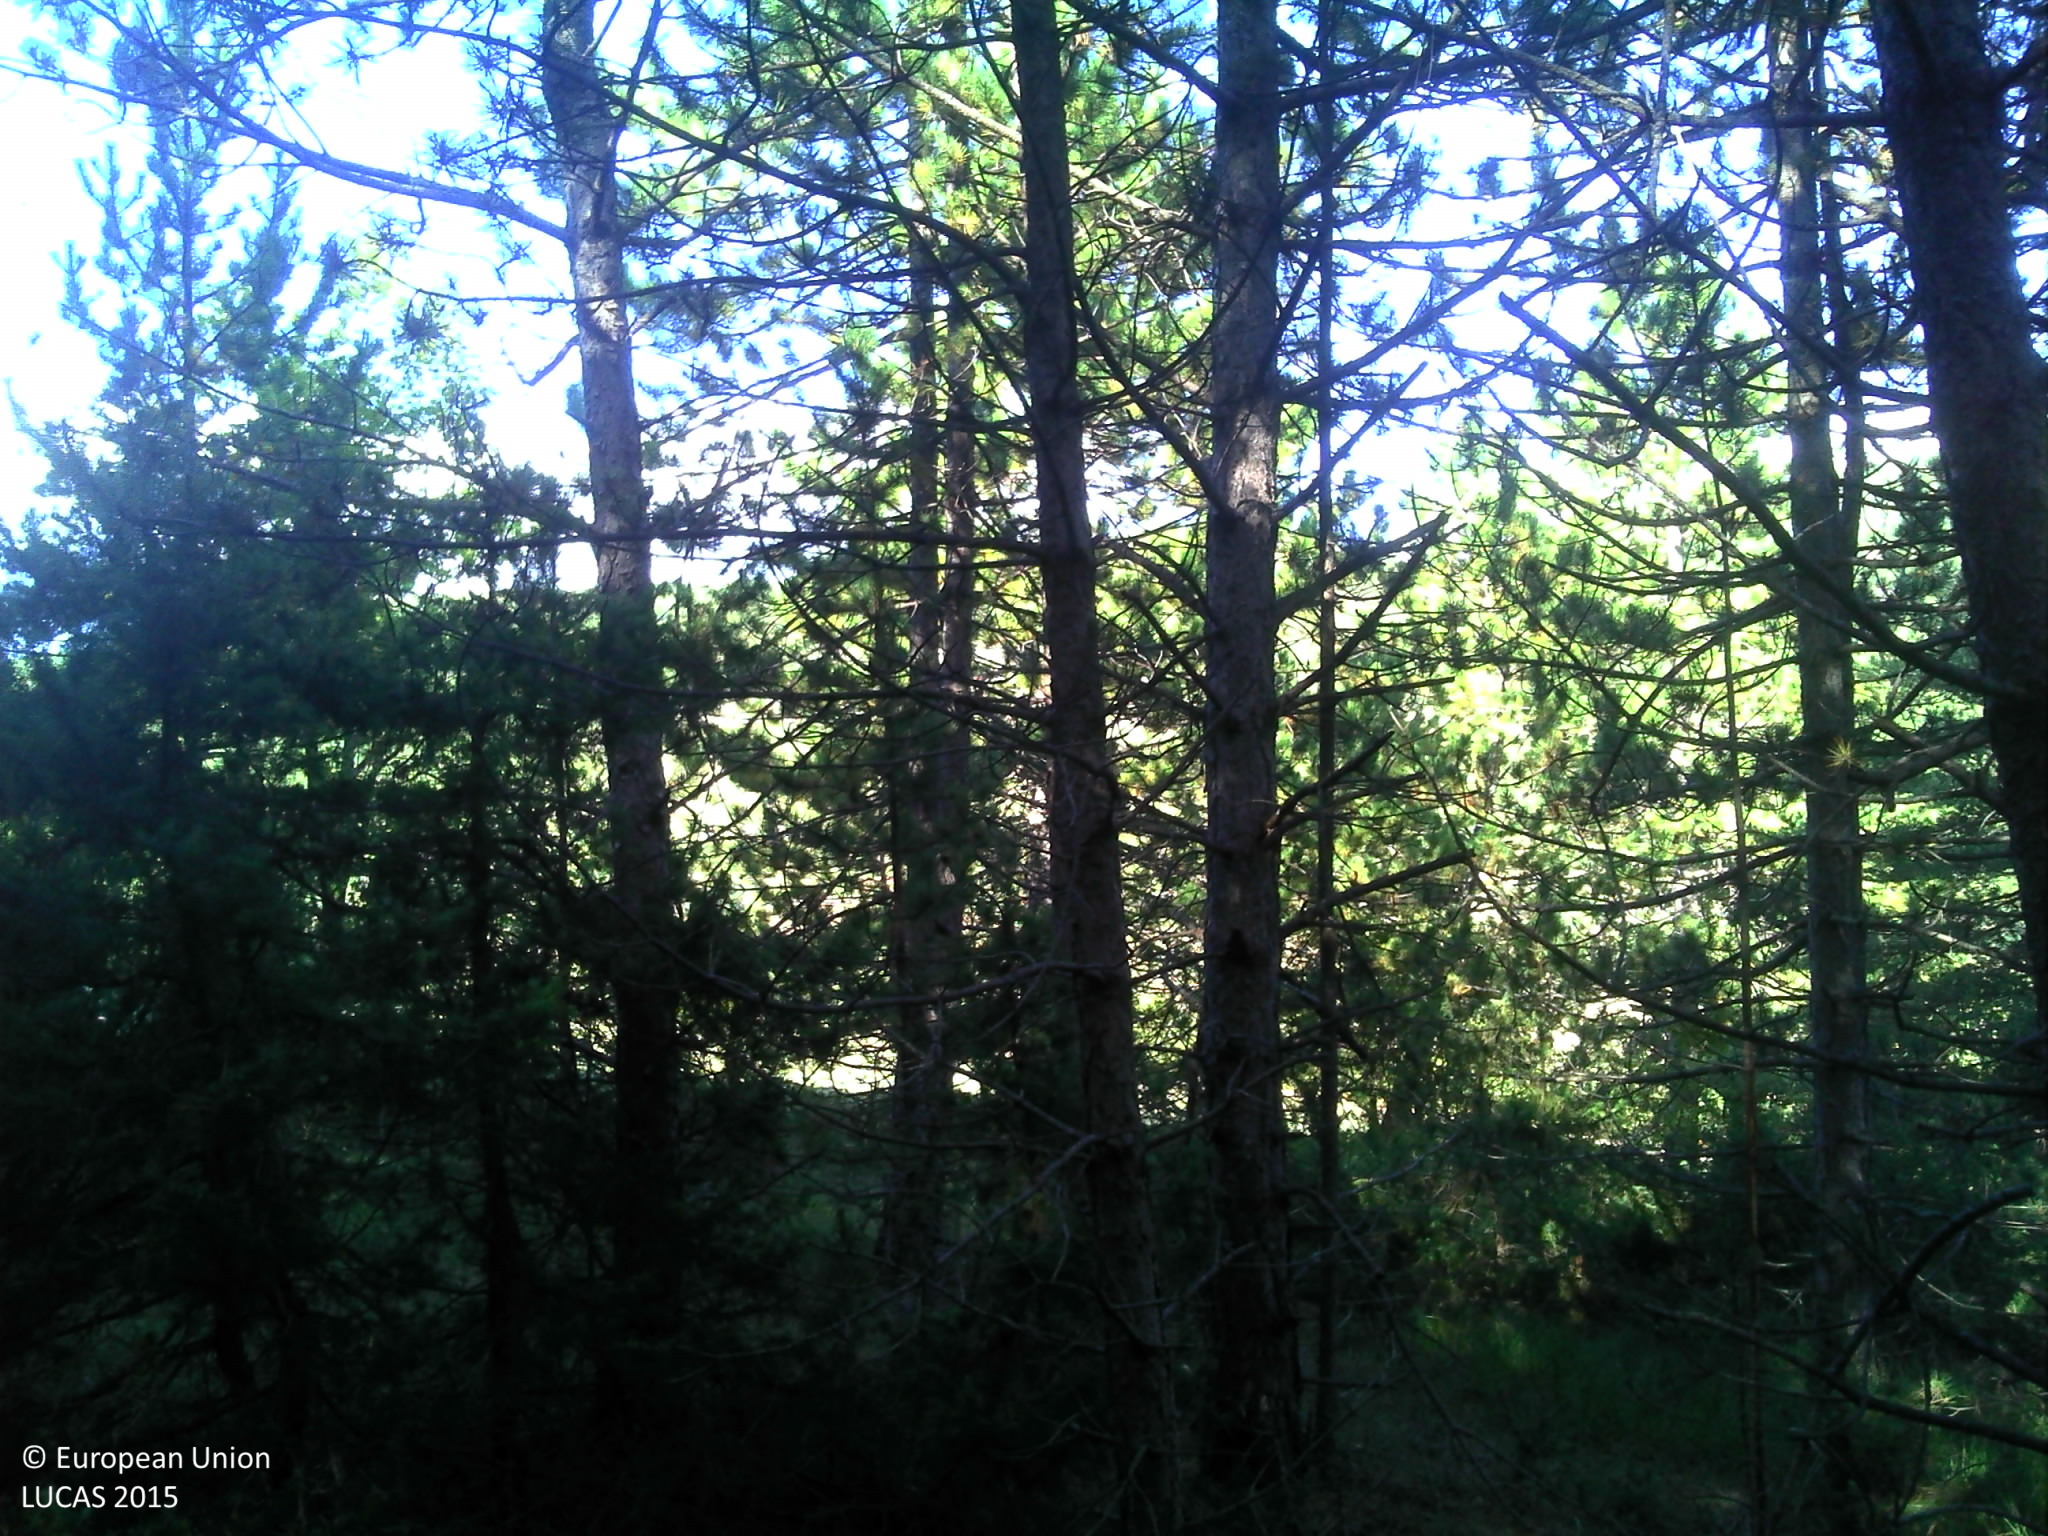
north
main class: Woodland
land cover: Pine dominated coniferous woodland
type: coniferous forest of the mediterranean region
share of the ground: > 75 %
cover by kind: coniferous forest trees 80 %, unconsolidated bare surface 15 %, broadleaved forest trees 5 %
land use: Forestry
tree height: > 5 m
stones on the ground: 10 - 25 %
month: September
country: FR
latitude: 44.2502
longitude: 5.4365
